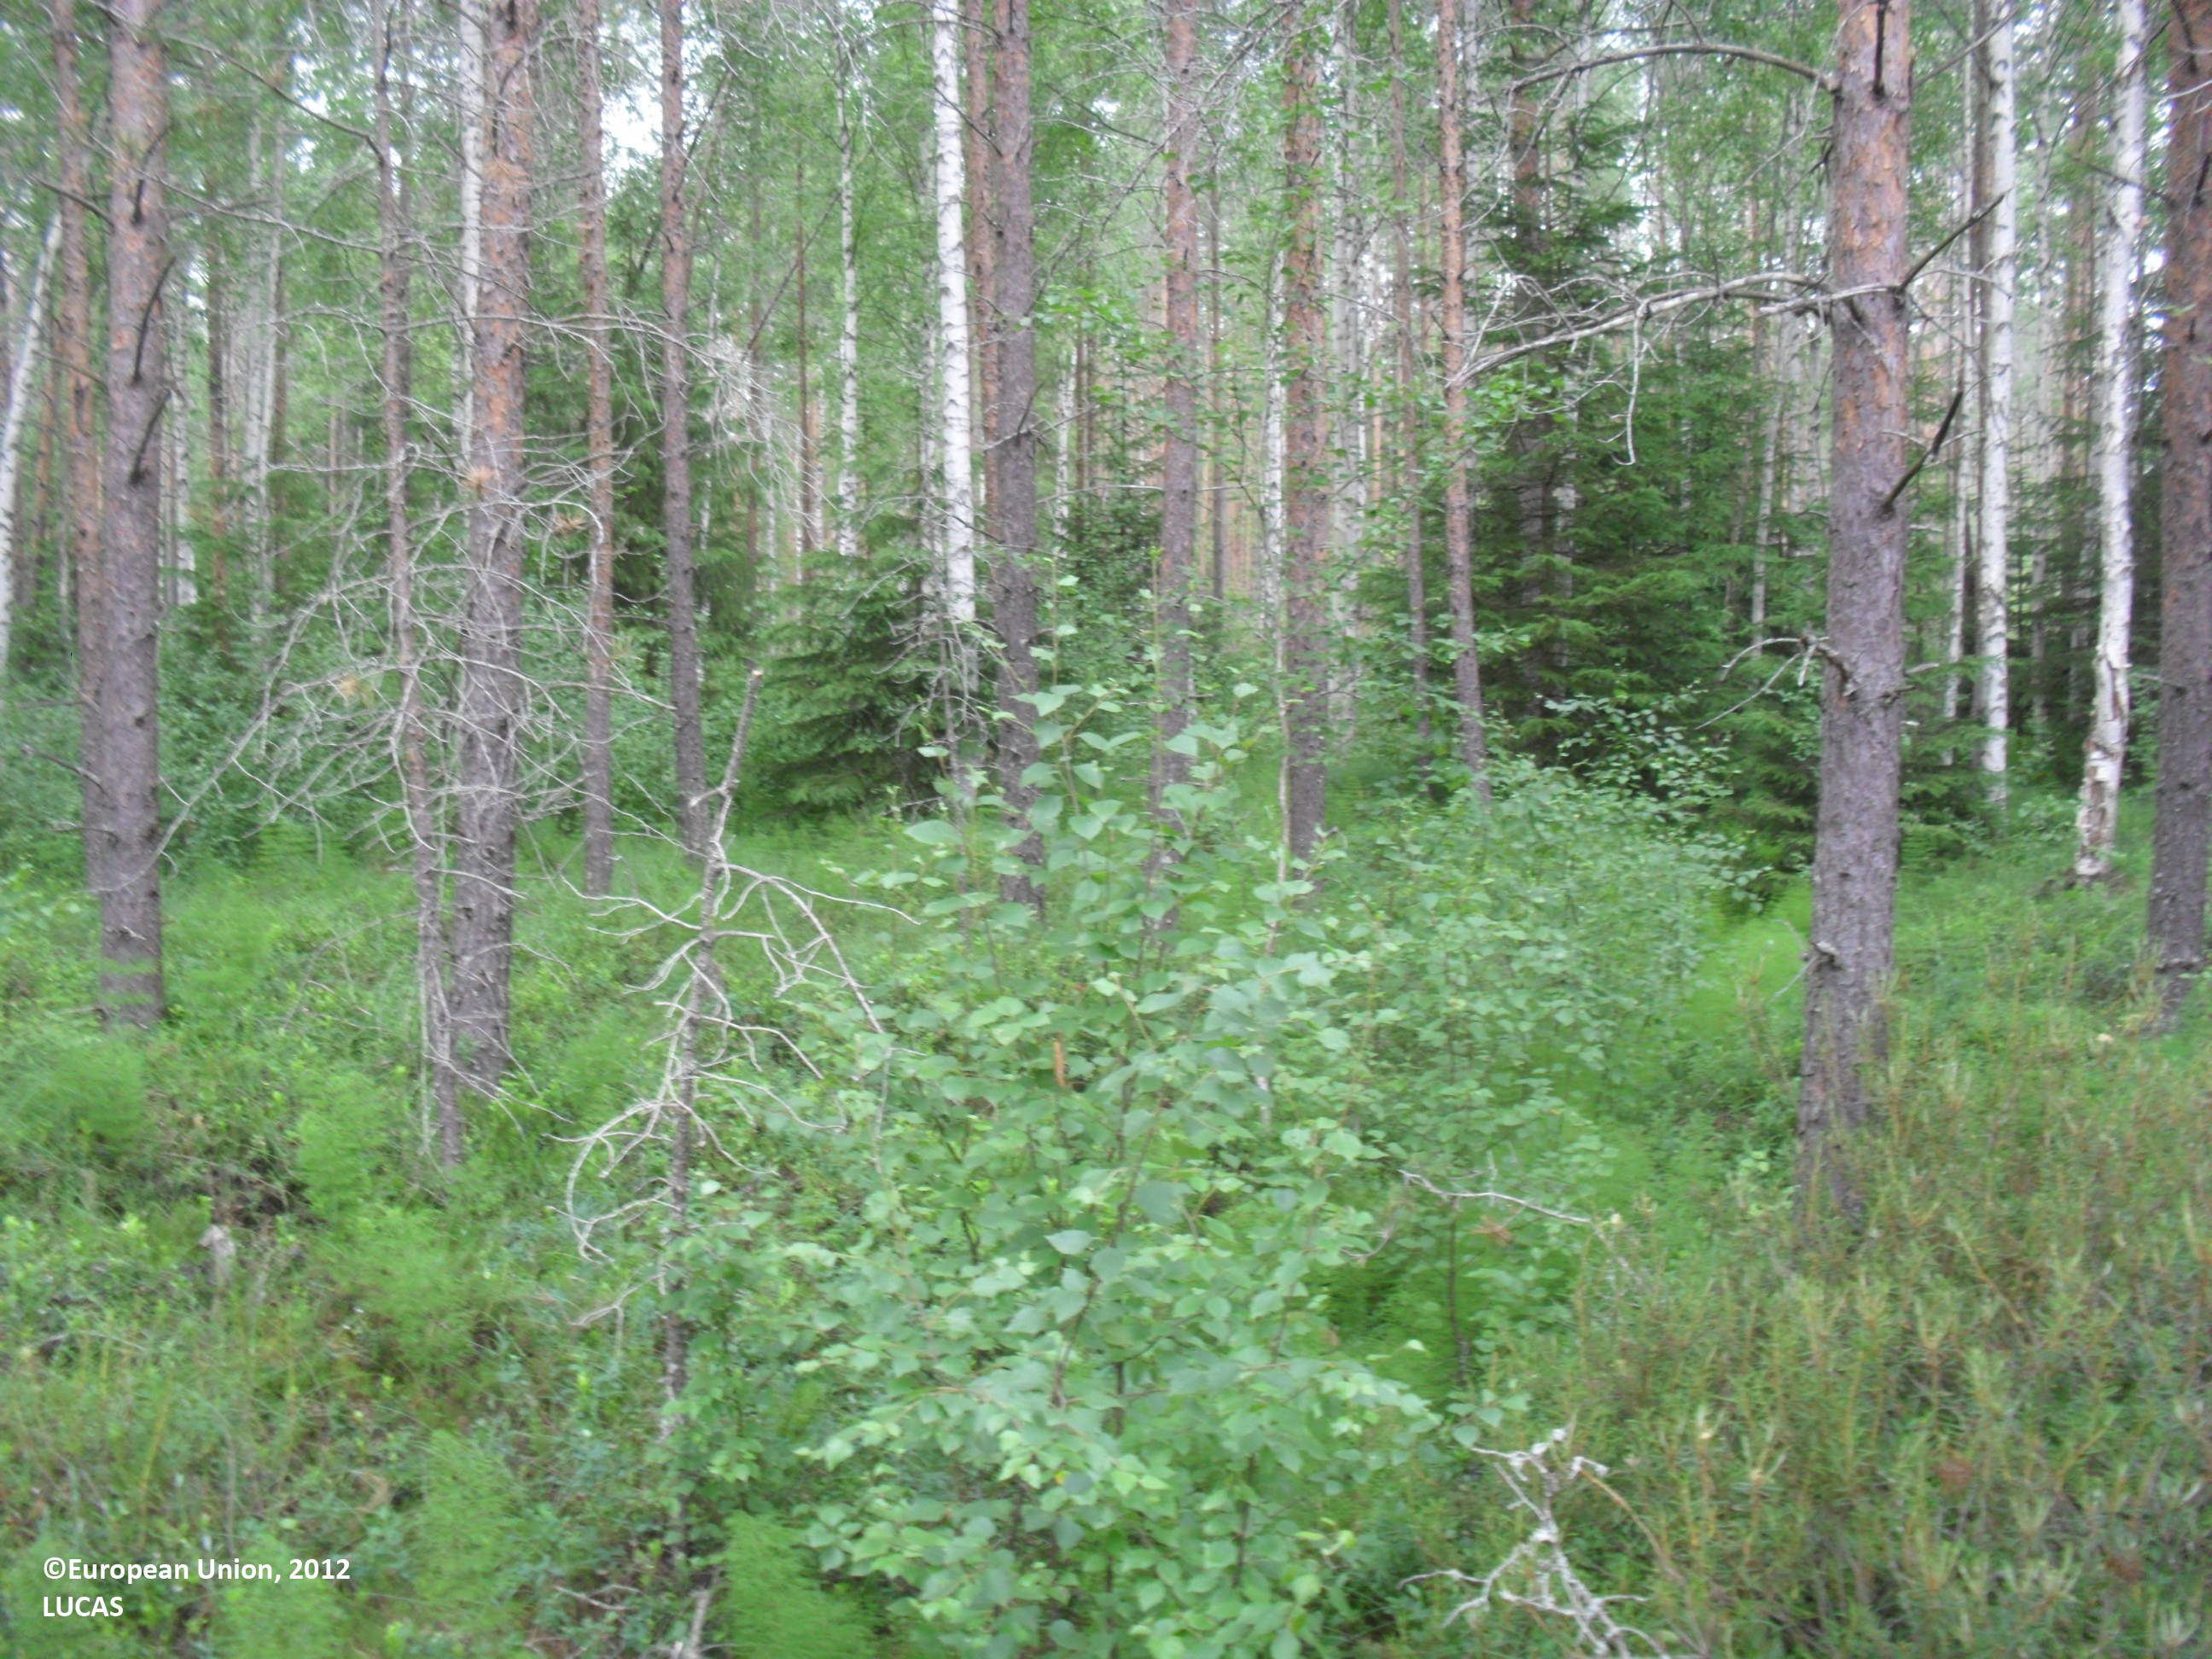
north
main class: Woodland
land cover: Pine dominated coniferous woodland
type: boreal forest
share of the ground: 50 - 75 %
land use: Forestry
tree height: > 5 m
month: July
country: FI
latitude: 63.6008
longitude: 23.6710
